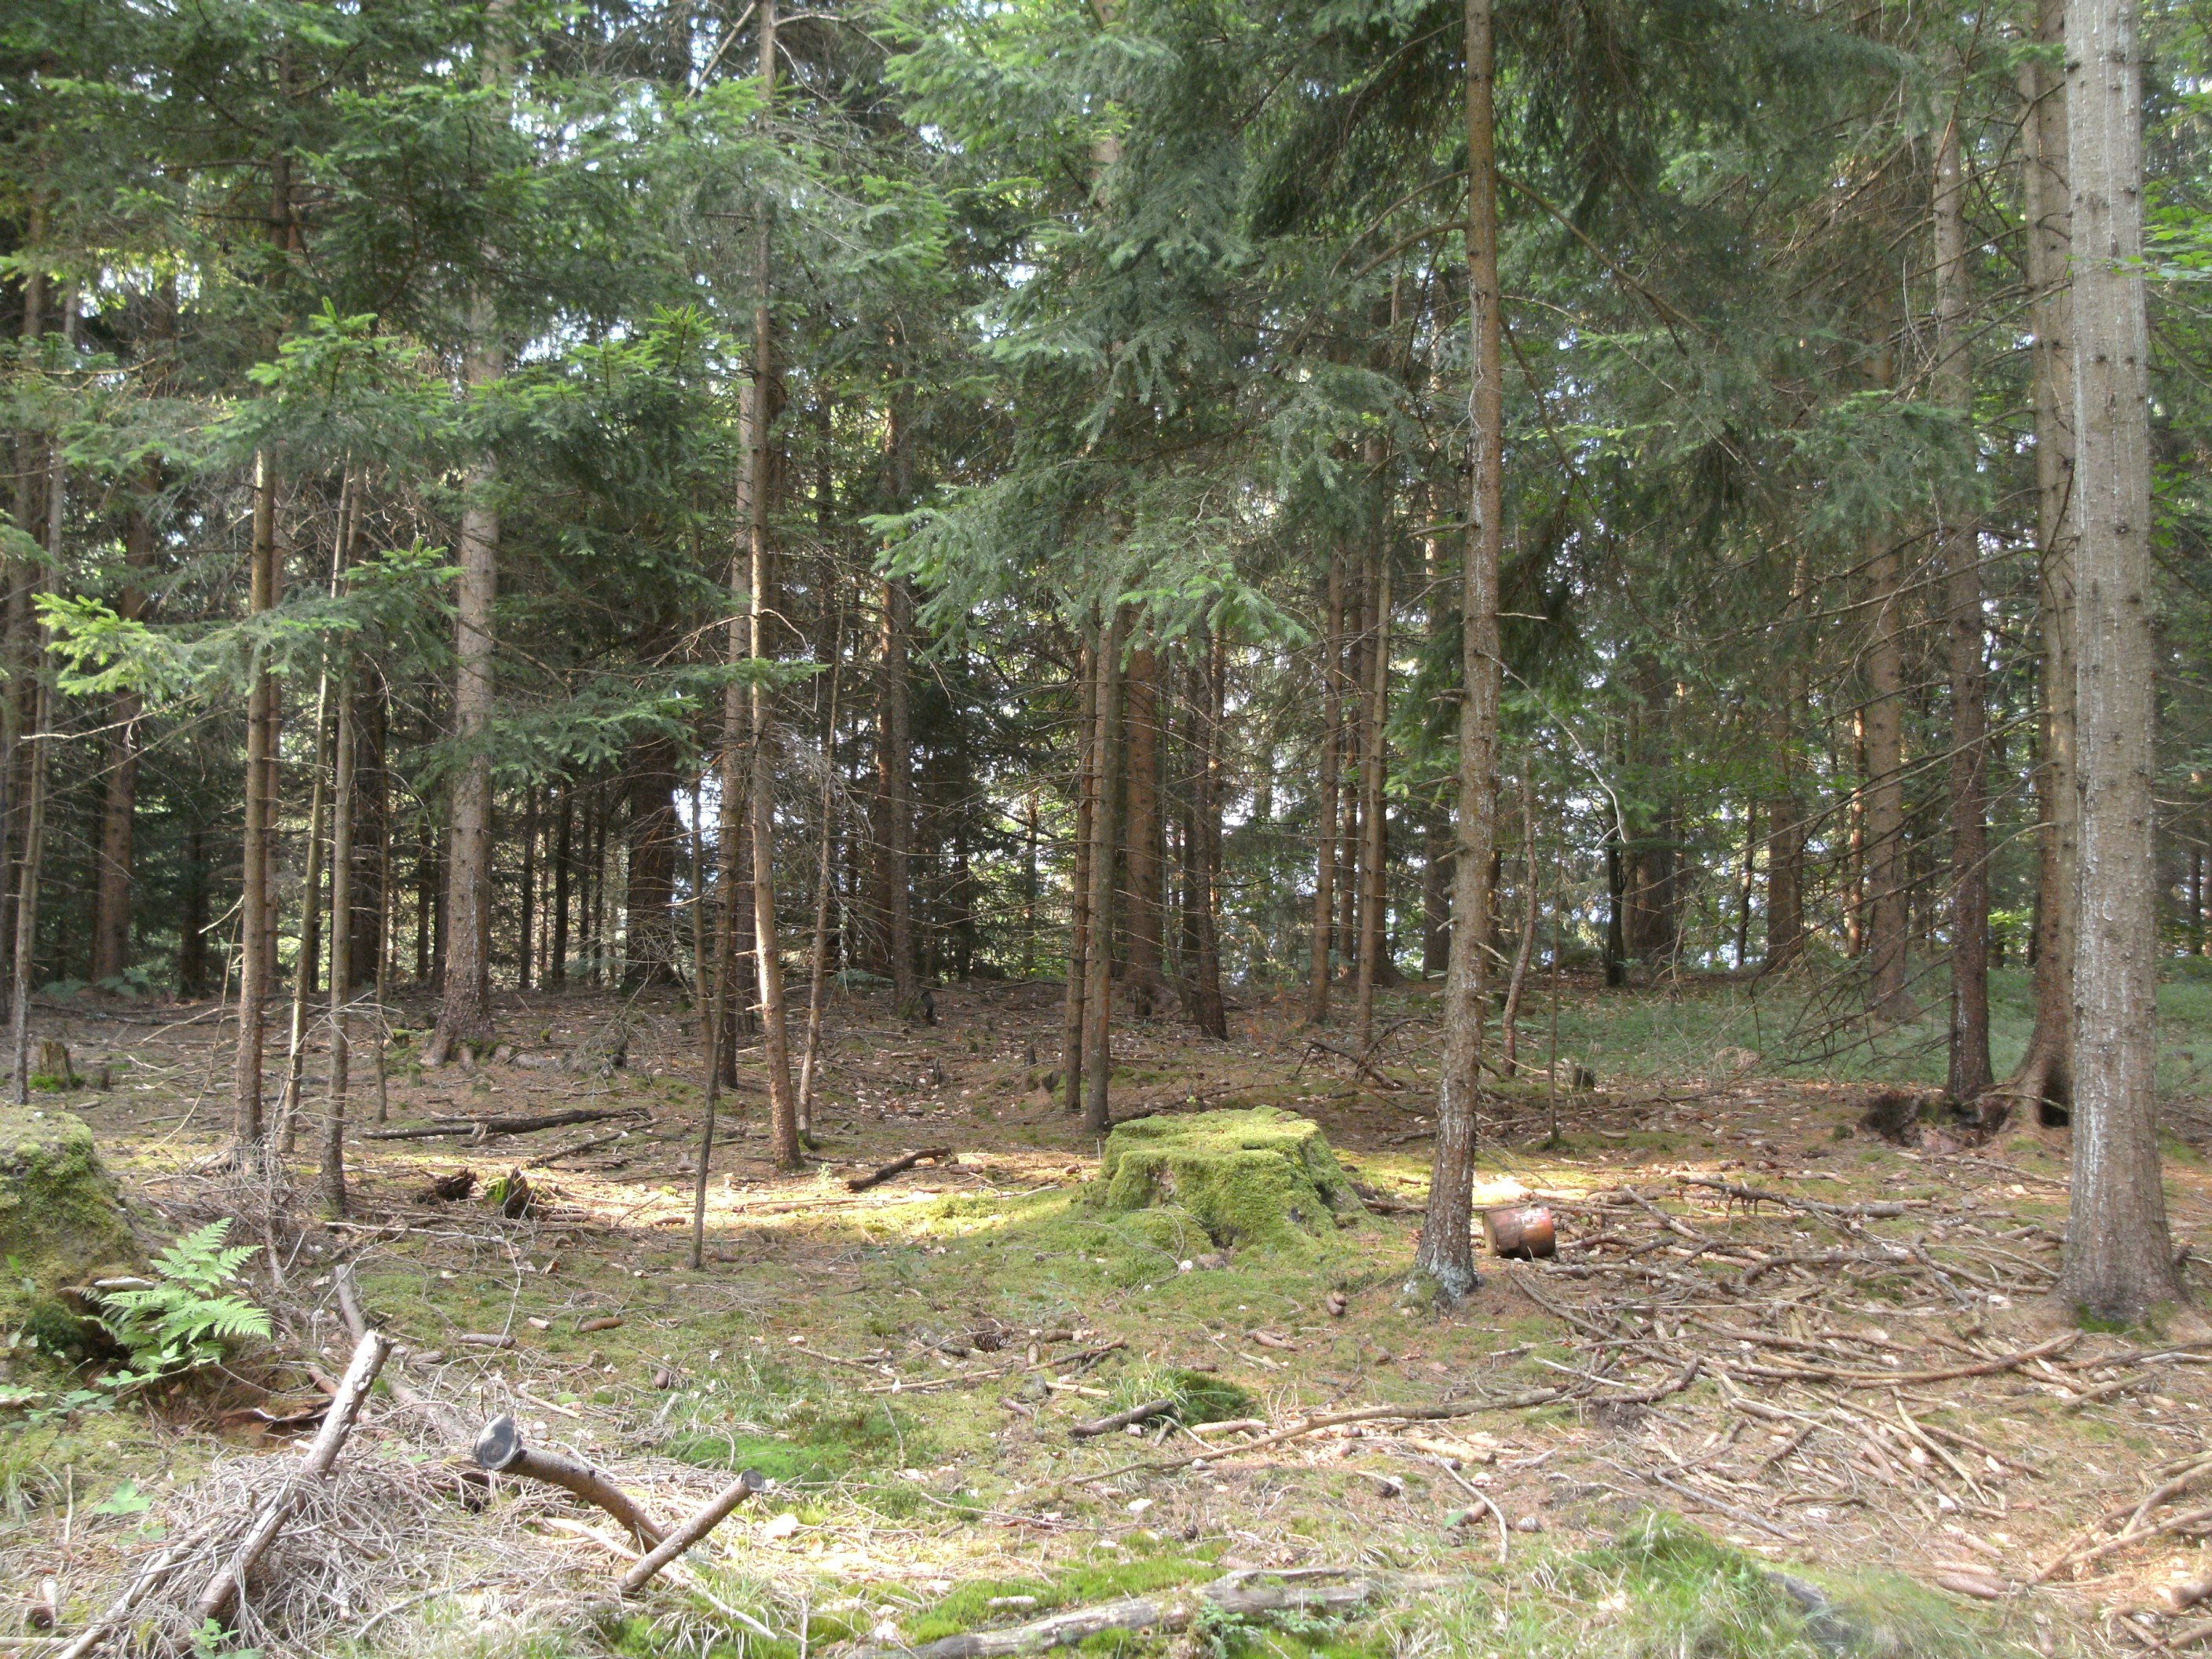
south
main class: Woodland
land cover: Spruce dominated coniferous woodland
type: hemiboreal forest and nemoral coniferous forest and mixed broadleaved-coniferous forest
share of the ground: 25 - 50 %
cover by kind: coniferous forest trees 45 %, shrubs 15 %, herbaceous plants 15 %, unconsolidated bare surface 15 %, broadleaved forest trees 5 %, lichens and mosses 5 %
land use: Forestry
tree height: > 5 m
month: July
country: AT
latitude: 46.7426
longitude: 14.9327
